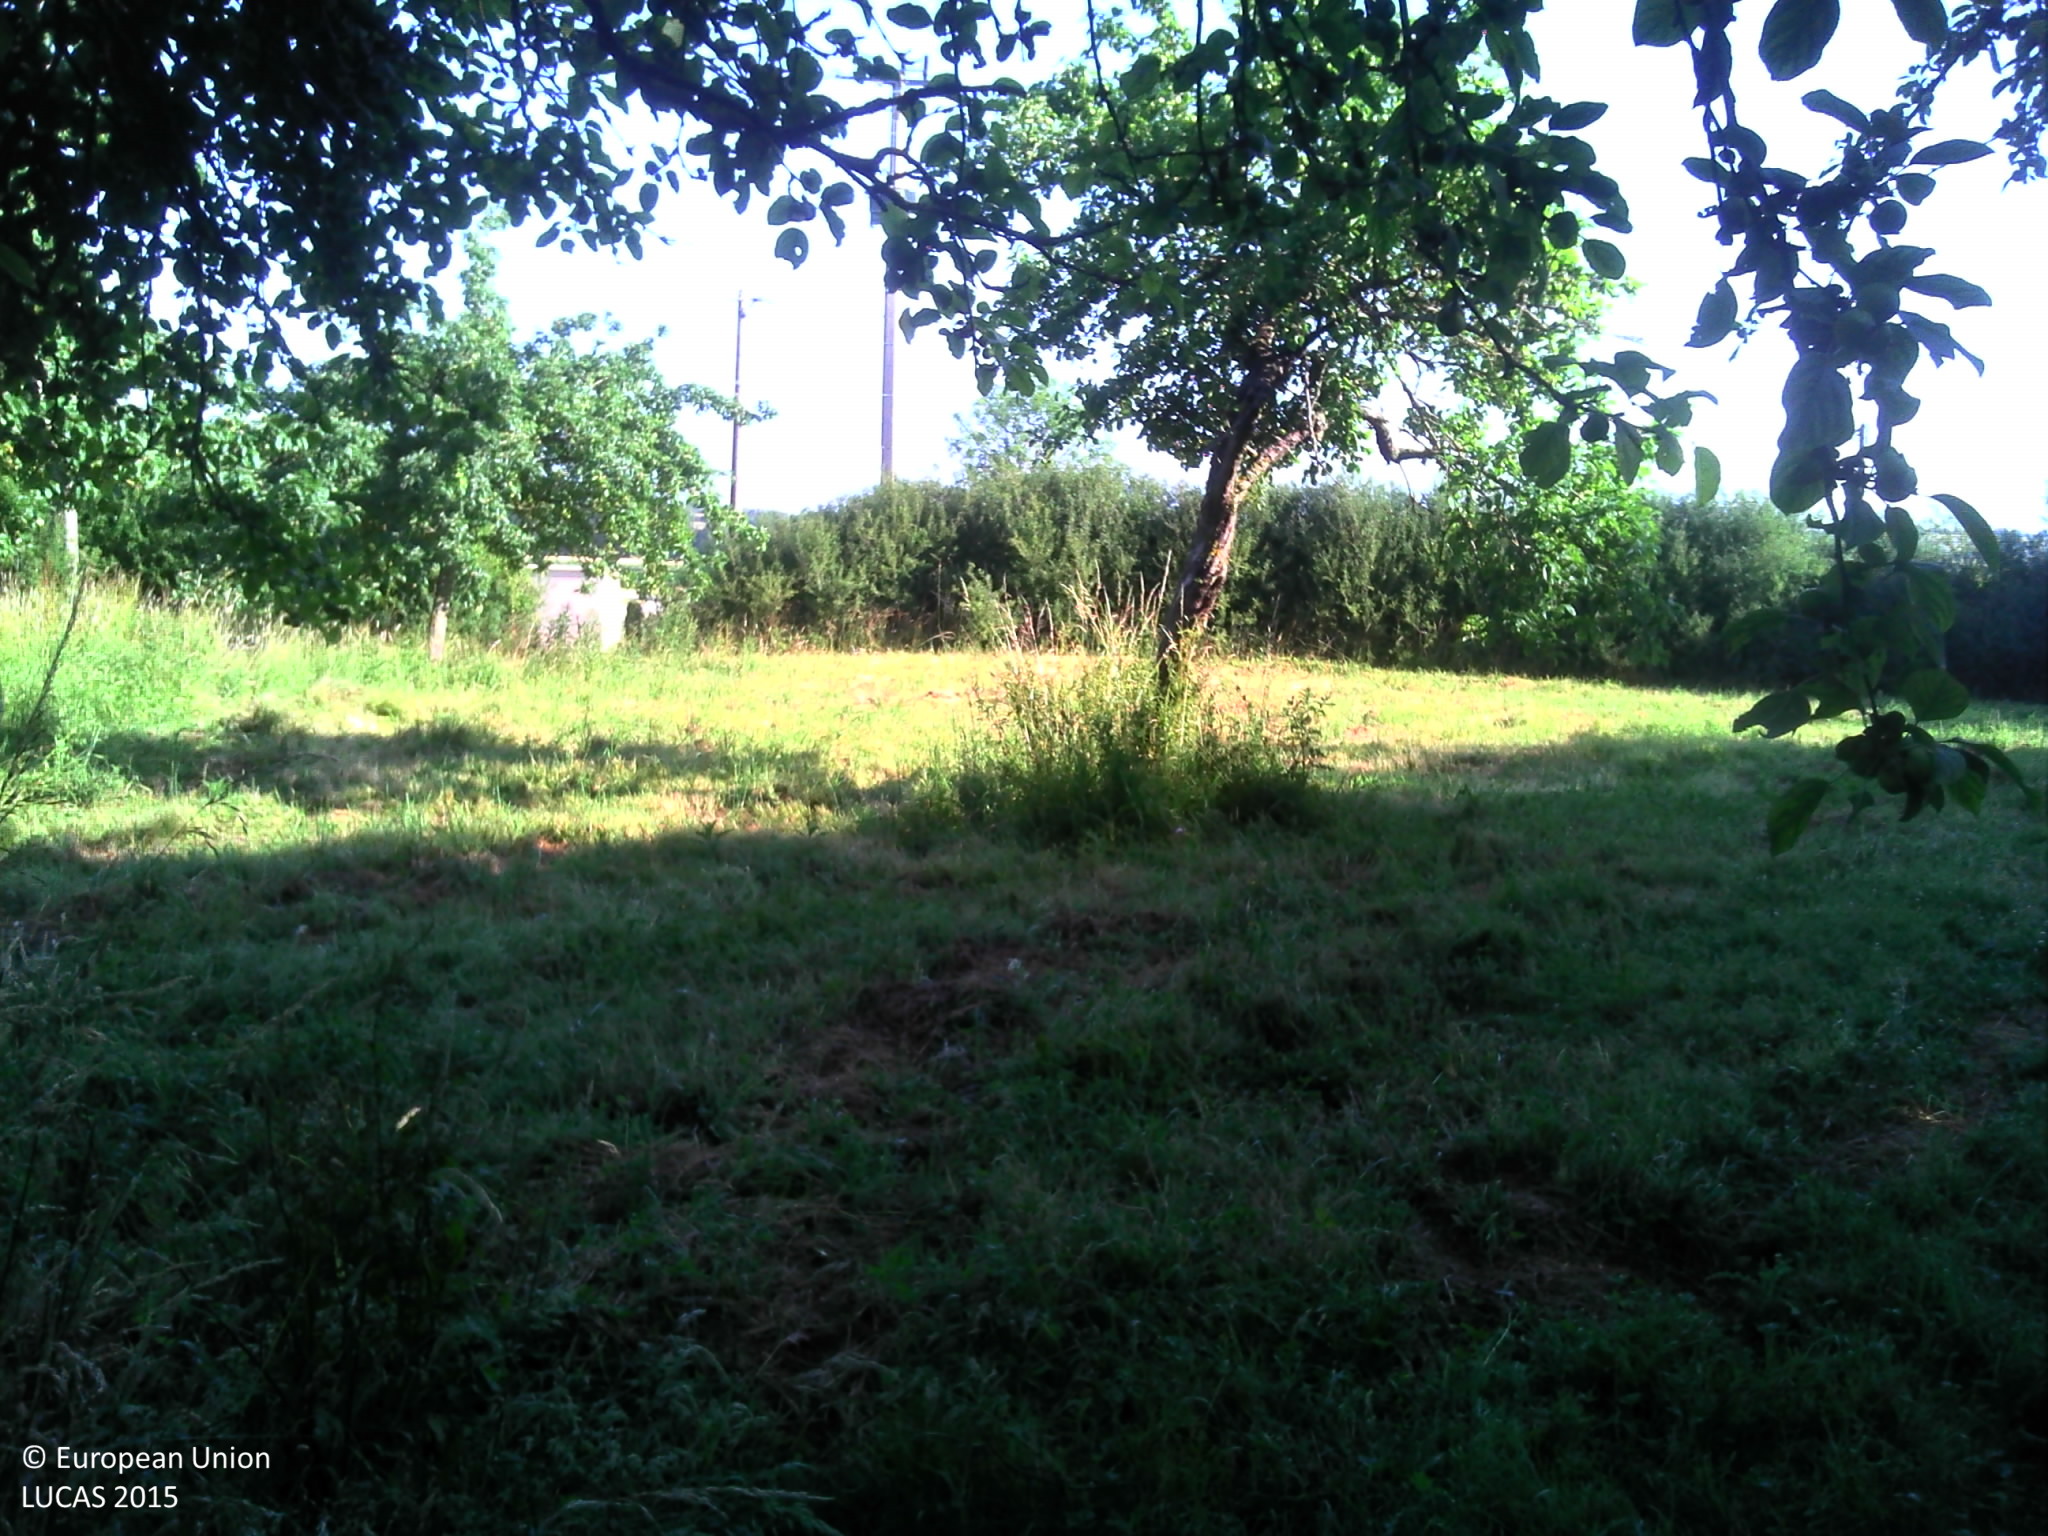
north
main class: Cropland
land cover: Apple fruit
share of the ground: 10 - 25 %
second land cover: Grassland without tree/shrub cover
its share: > 75 %
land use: Agriculture (excluding fallow land and kitchen gardens)
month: July
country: FR
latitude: 49.0365
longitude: -0.0027
